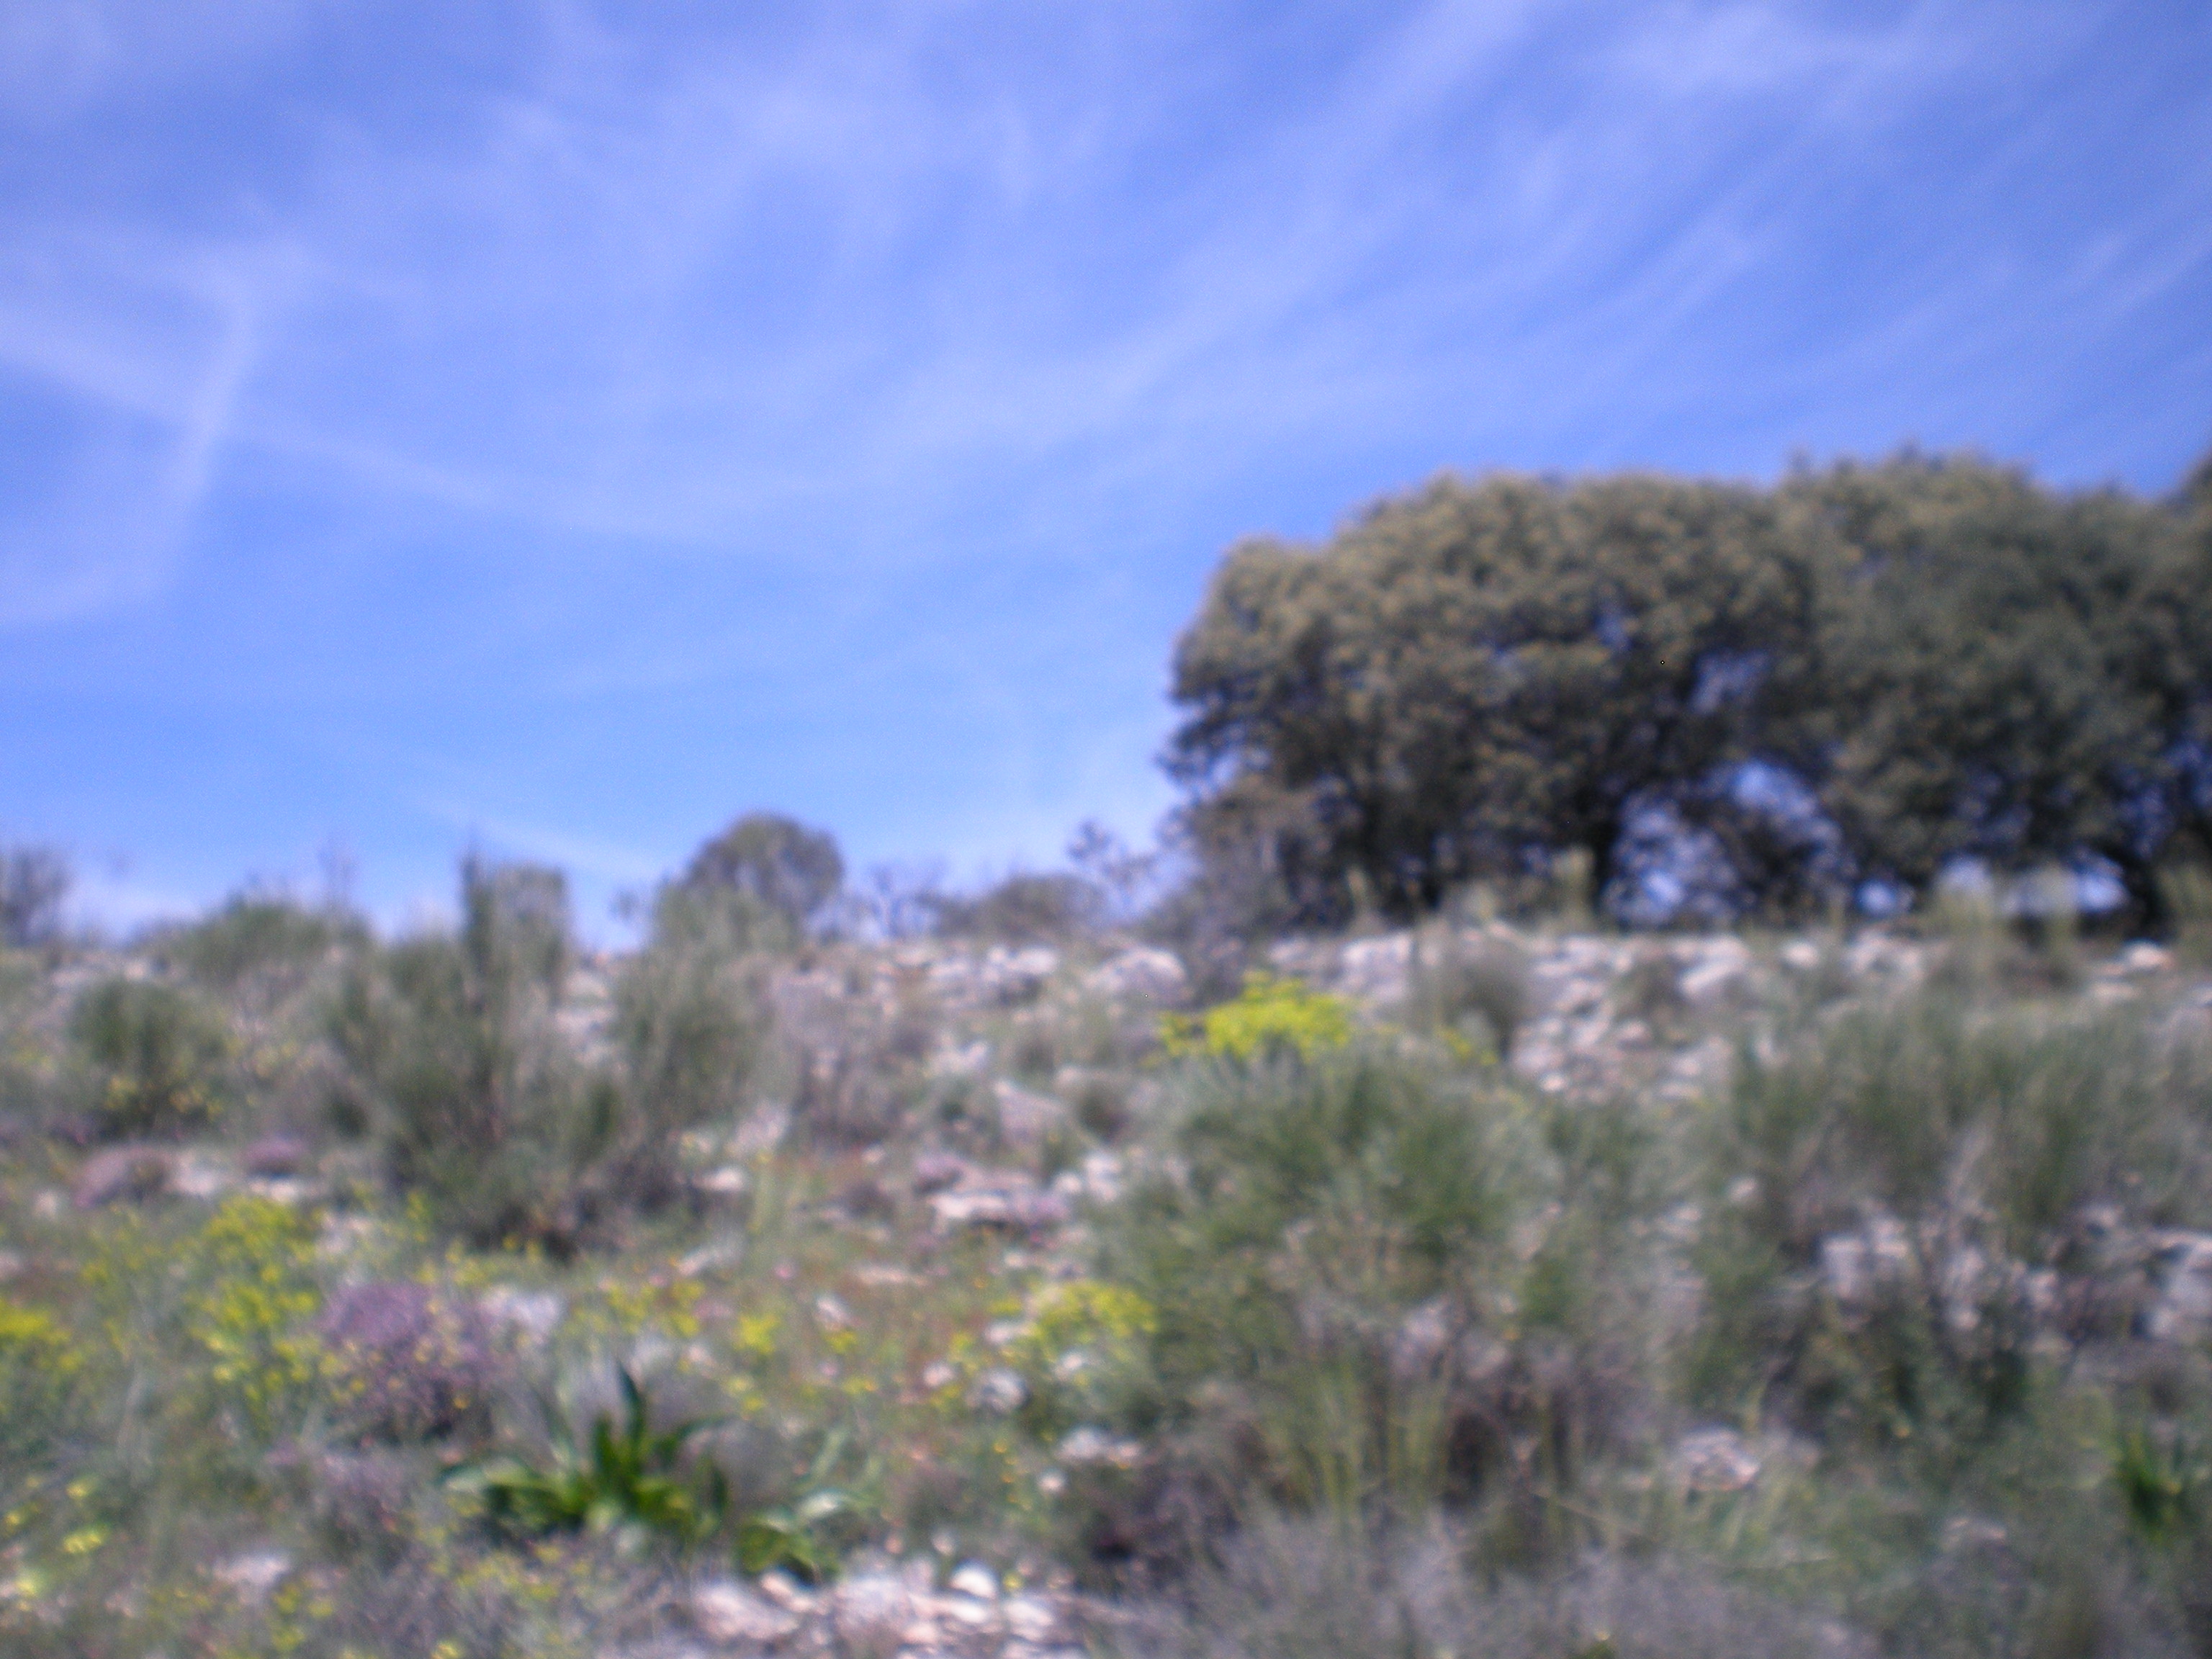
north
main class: Shrubland
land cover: Shrubland with sparse tree cover
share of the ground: 10 - 25 %
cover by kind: herbaceous plants 50 %, consolidated bare surface 30 %, shrubs 15 %, broadleaved forest trees 5 %
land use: Semi-natural and natural areas not in use
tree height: < 5 m
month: April
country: ES
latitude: 38.5915
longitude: -2.8737
